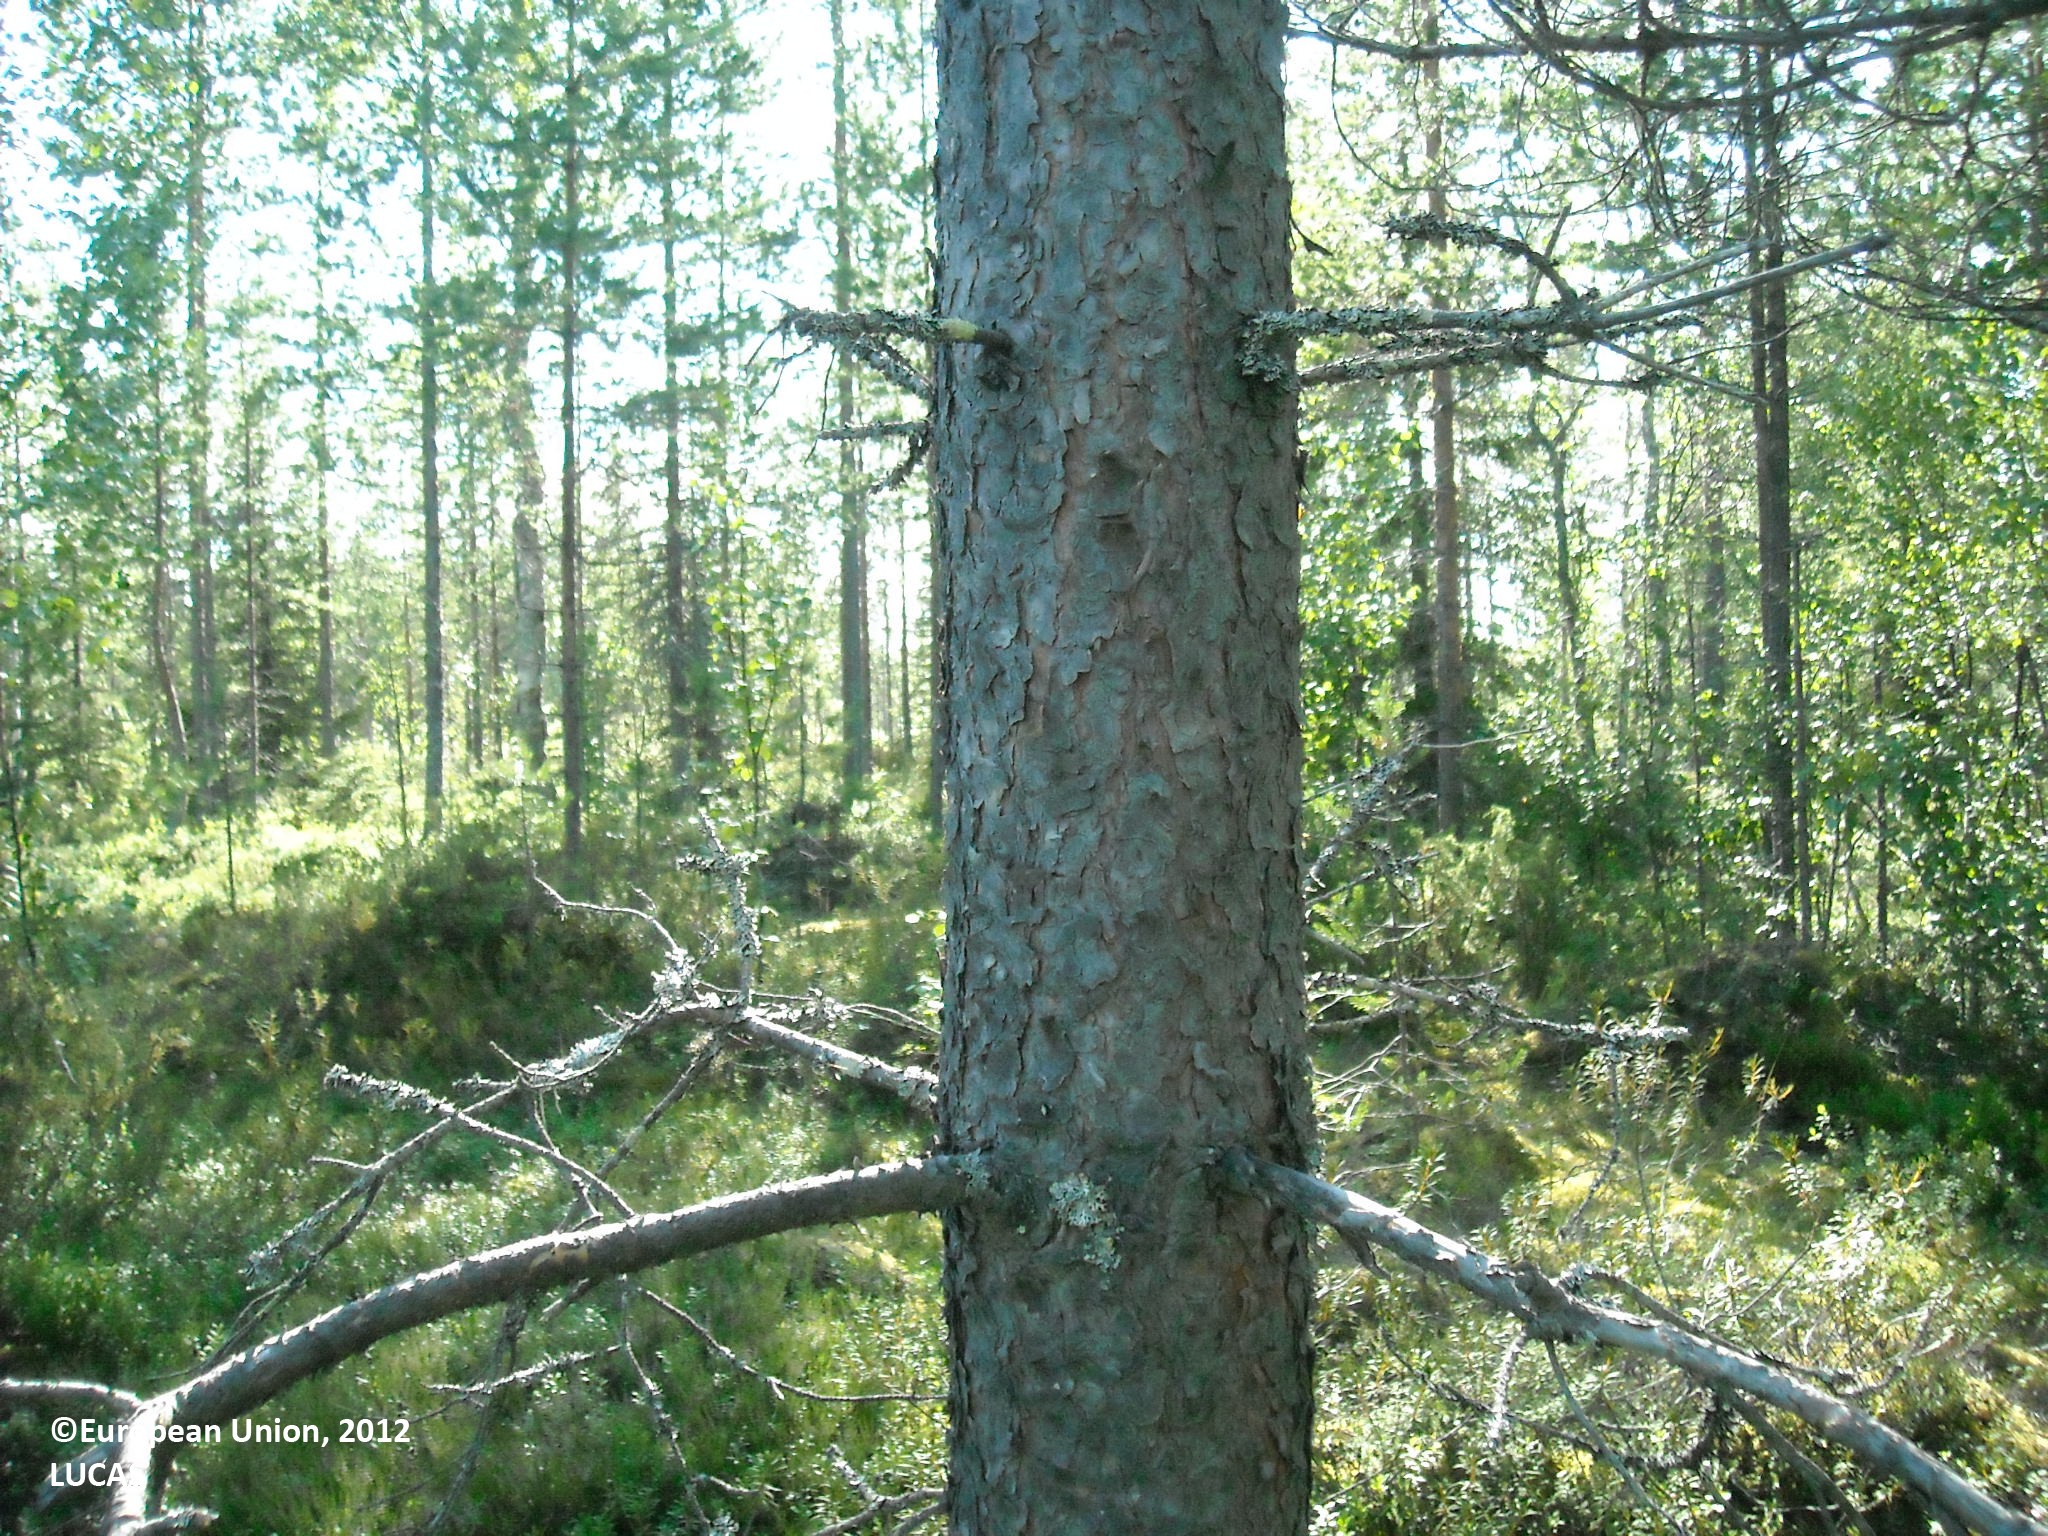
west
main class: Woodland
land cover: Other mixed woodland
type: boreal forest
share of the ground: 50 - 75 %
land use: Forestry
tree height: > 5 m
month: July
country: FI
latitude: 65.1731
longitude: 27.7511
